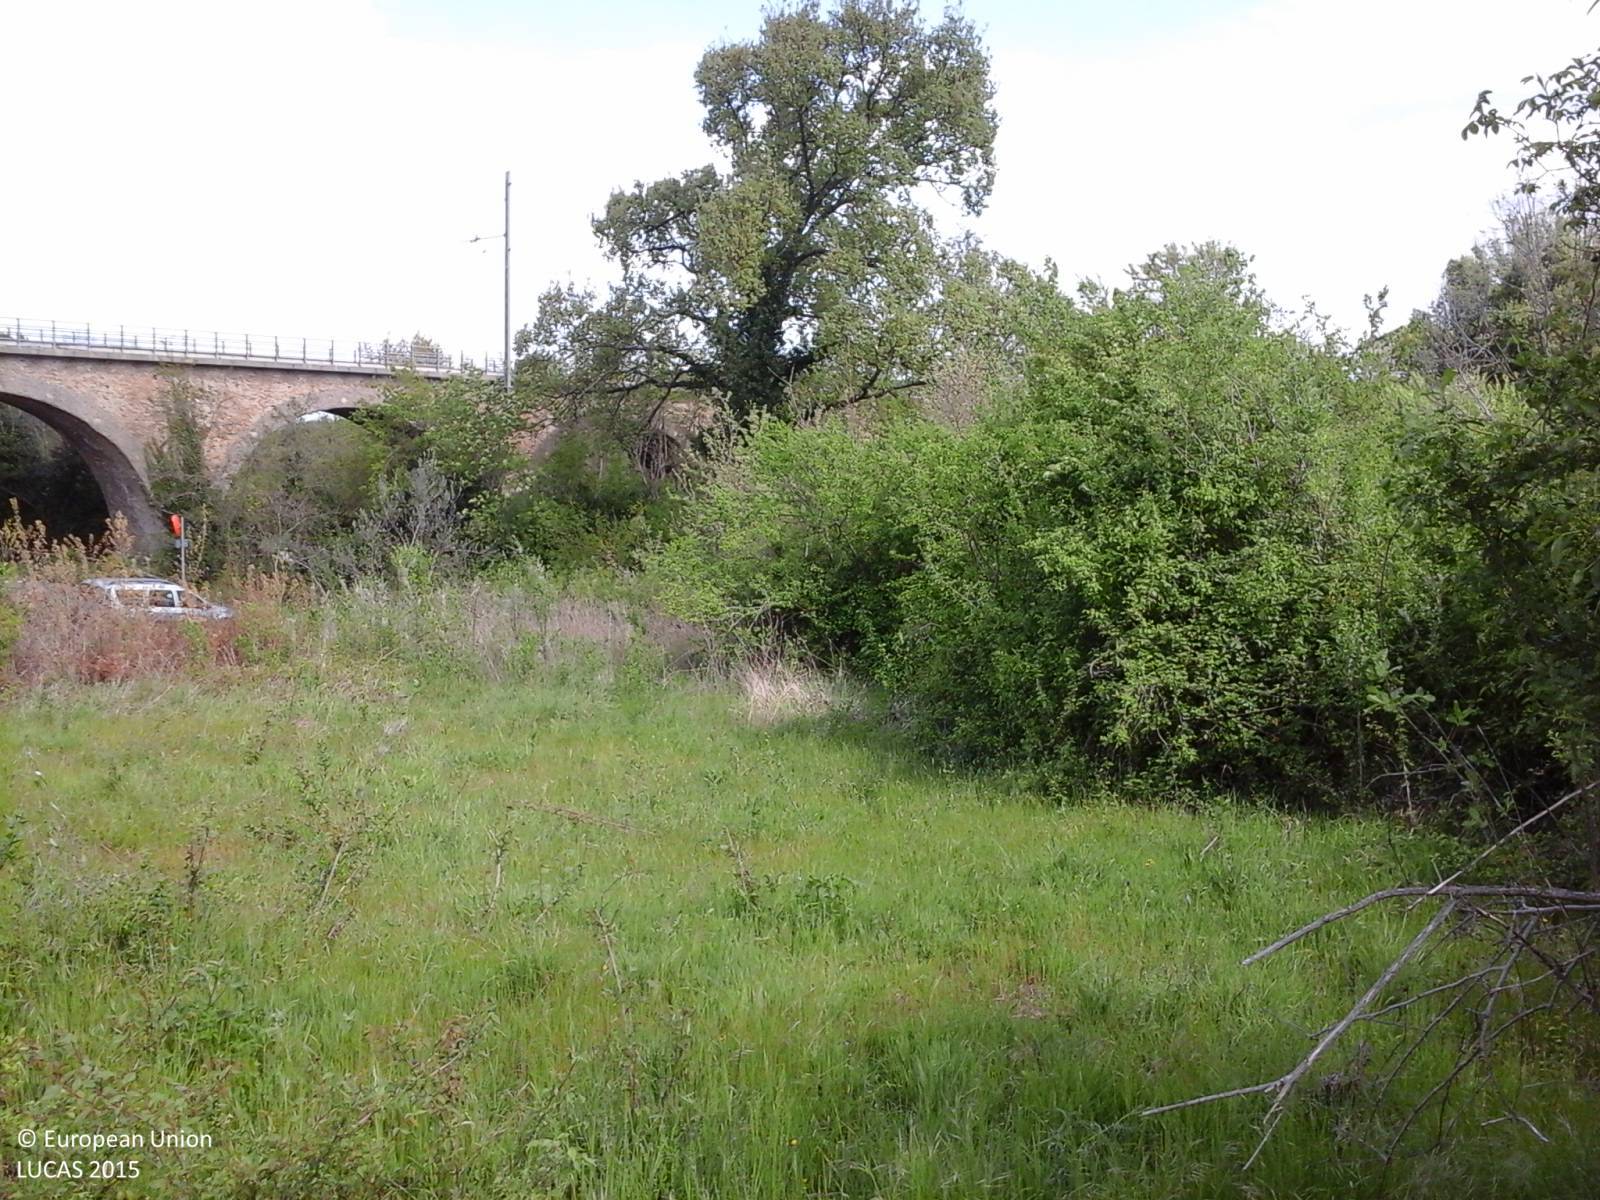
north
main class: Cropland
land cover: Olive groves
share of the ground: 25 - 50 %
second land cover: Grassland without tree/shrub cover
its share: > 75 %
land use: Agriculture (excluding fallow land and kitchen gardens)
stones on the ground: < 10 %
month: May
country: IT
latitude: 42.3614
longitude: 12.0933
